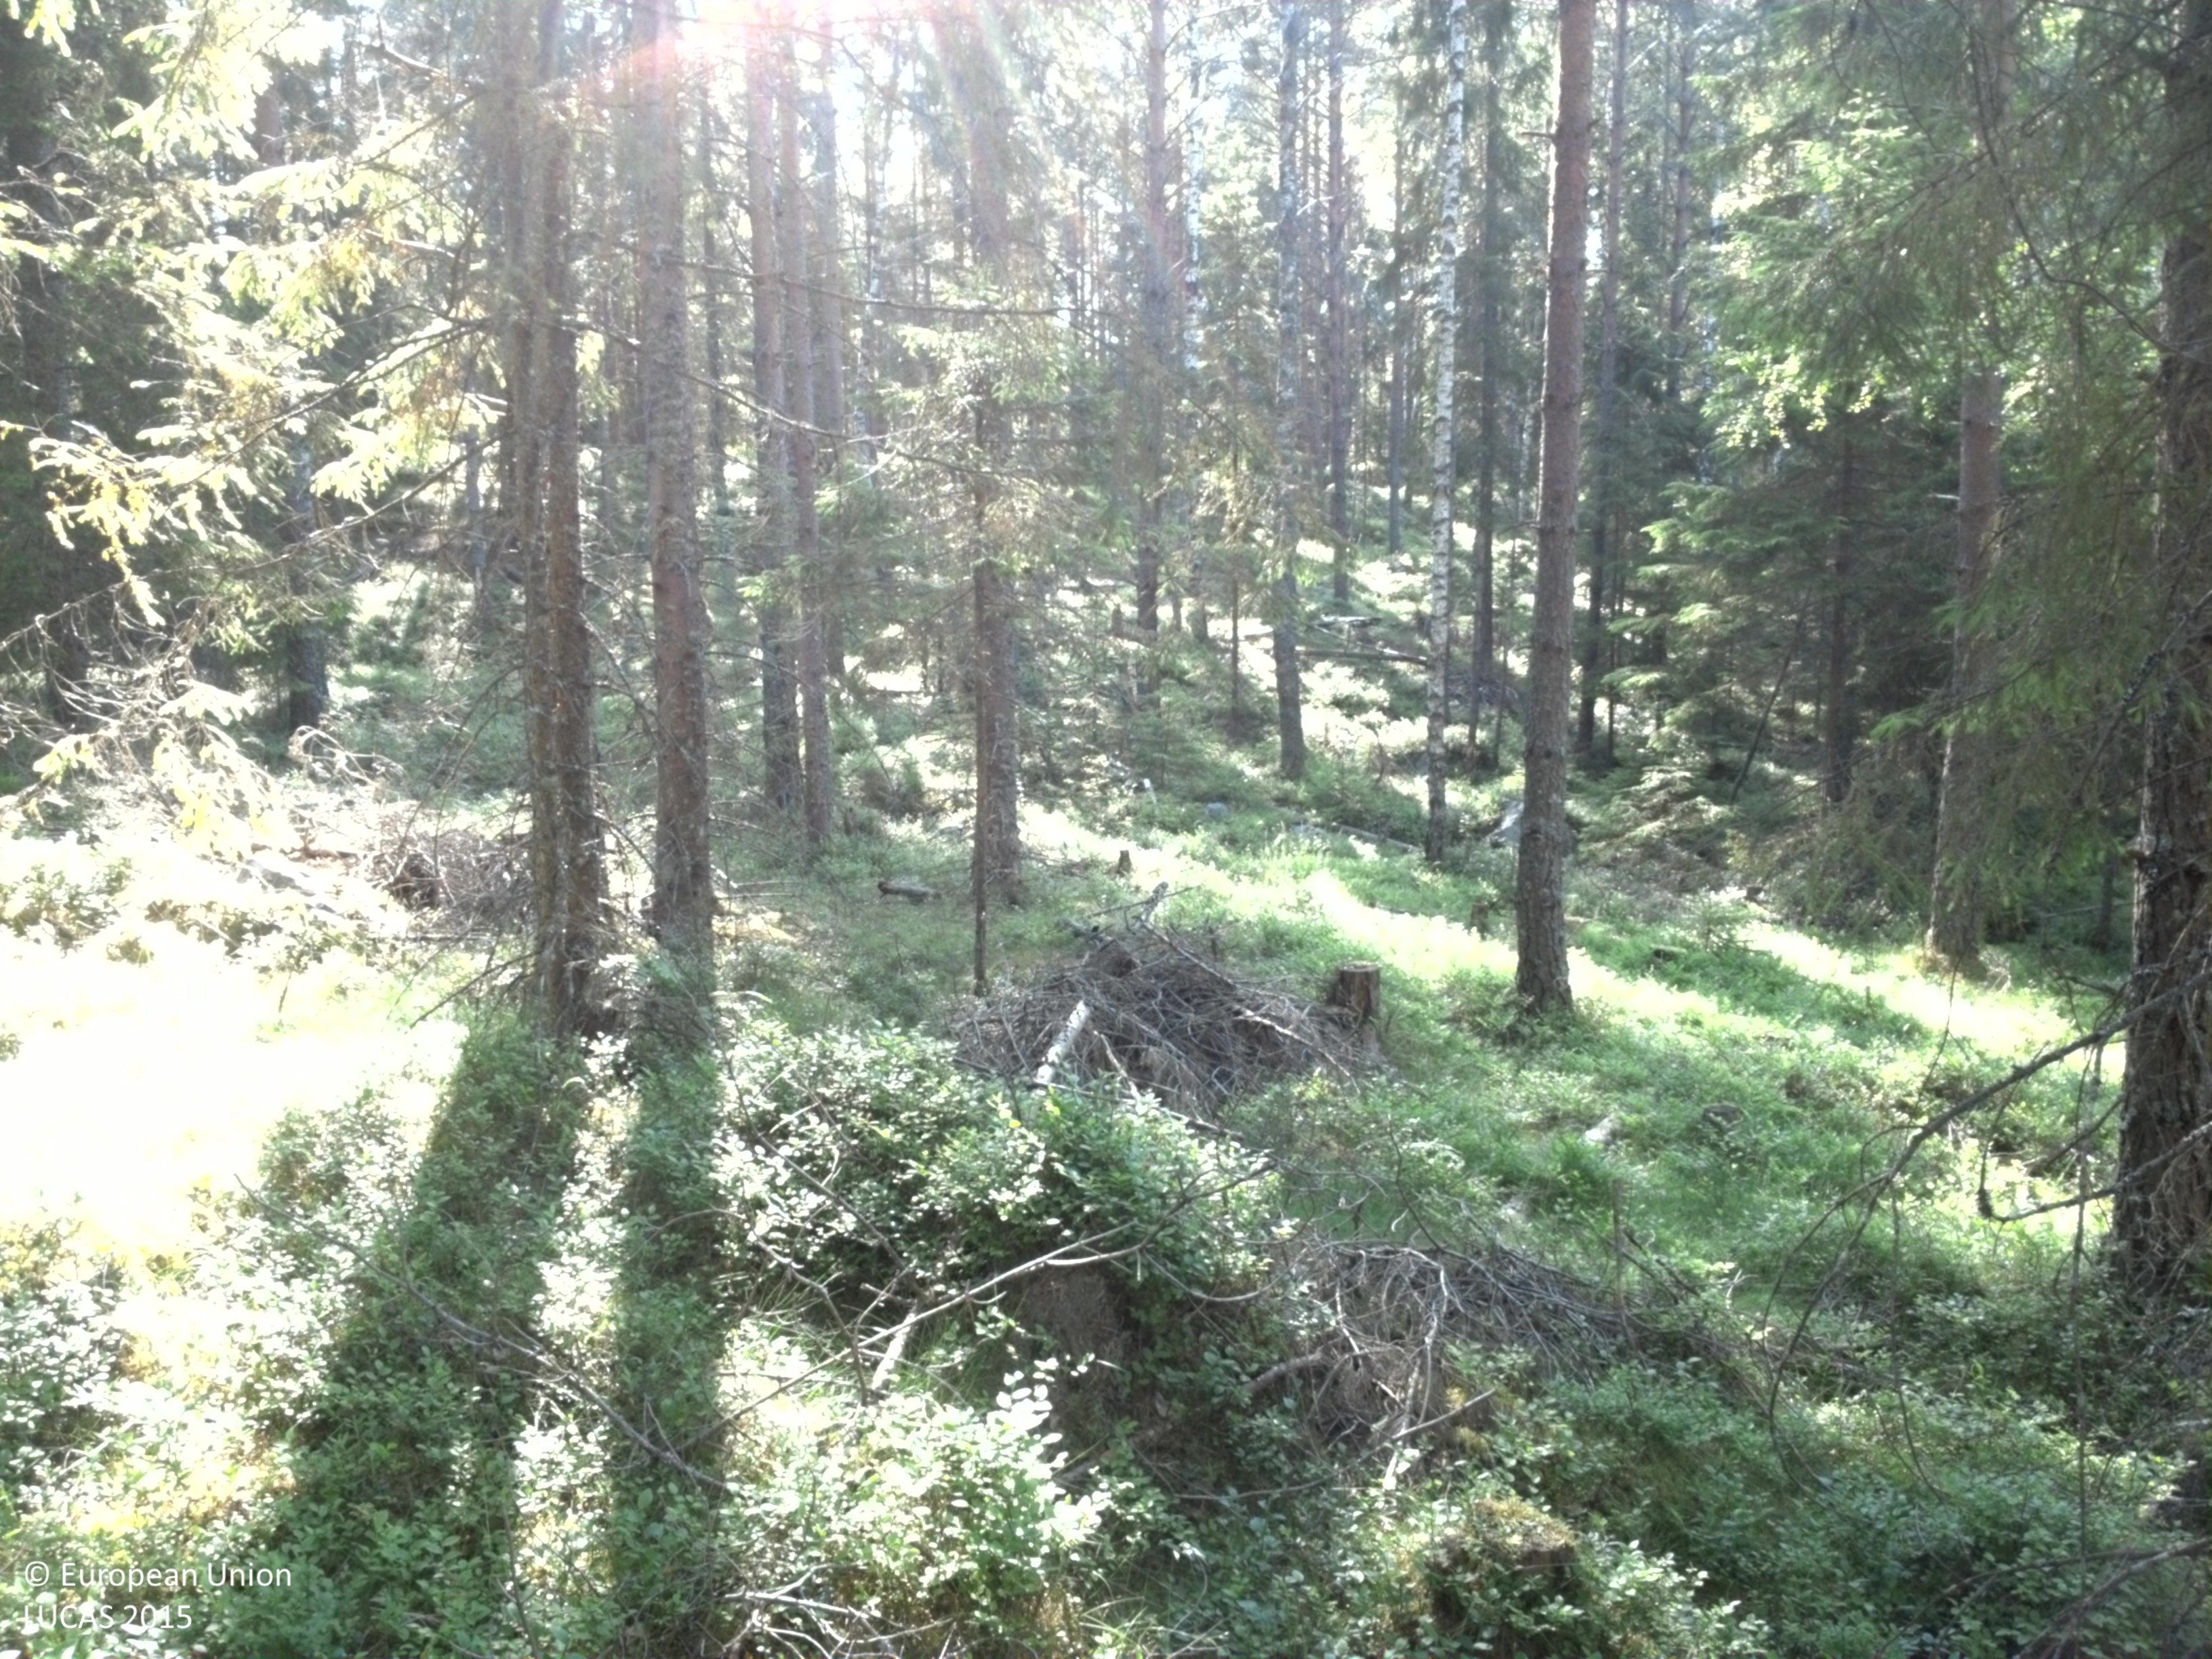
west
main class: Woodland
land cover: Pine dominated mixed woodland
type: boreal forest
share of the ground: 50 - 75 %
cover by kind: coniferous forest trees 40 %, shrubs 30 %, broadleaved forest trees 20 %, herbaceous plants 5 %, consolidated bare surface 5 %
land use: Forestry
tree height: > 5 m
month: July
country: SE
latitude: 59.1695
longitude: 14.5576
